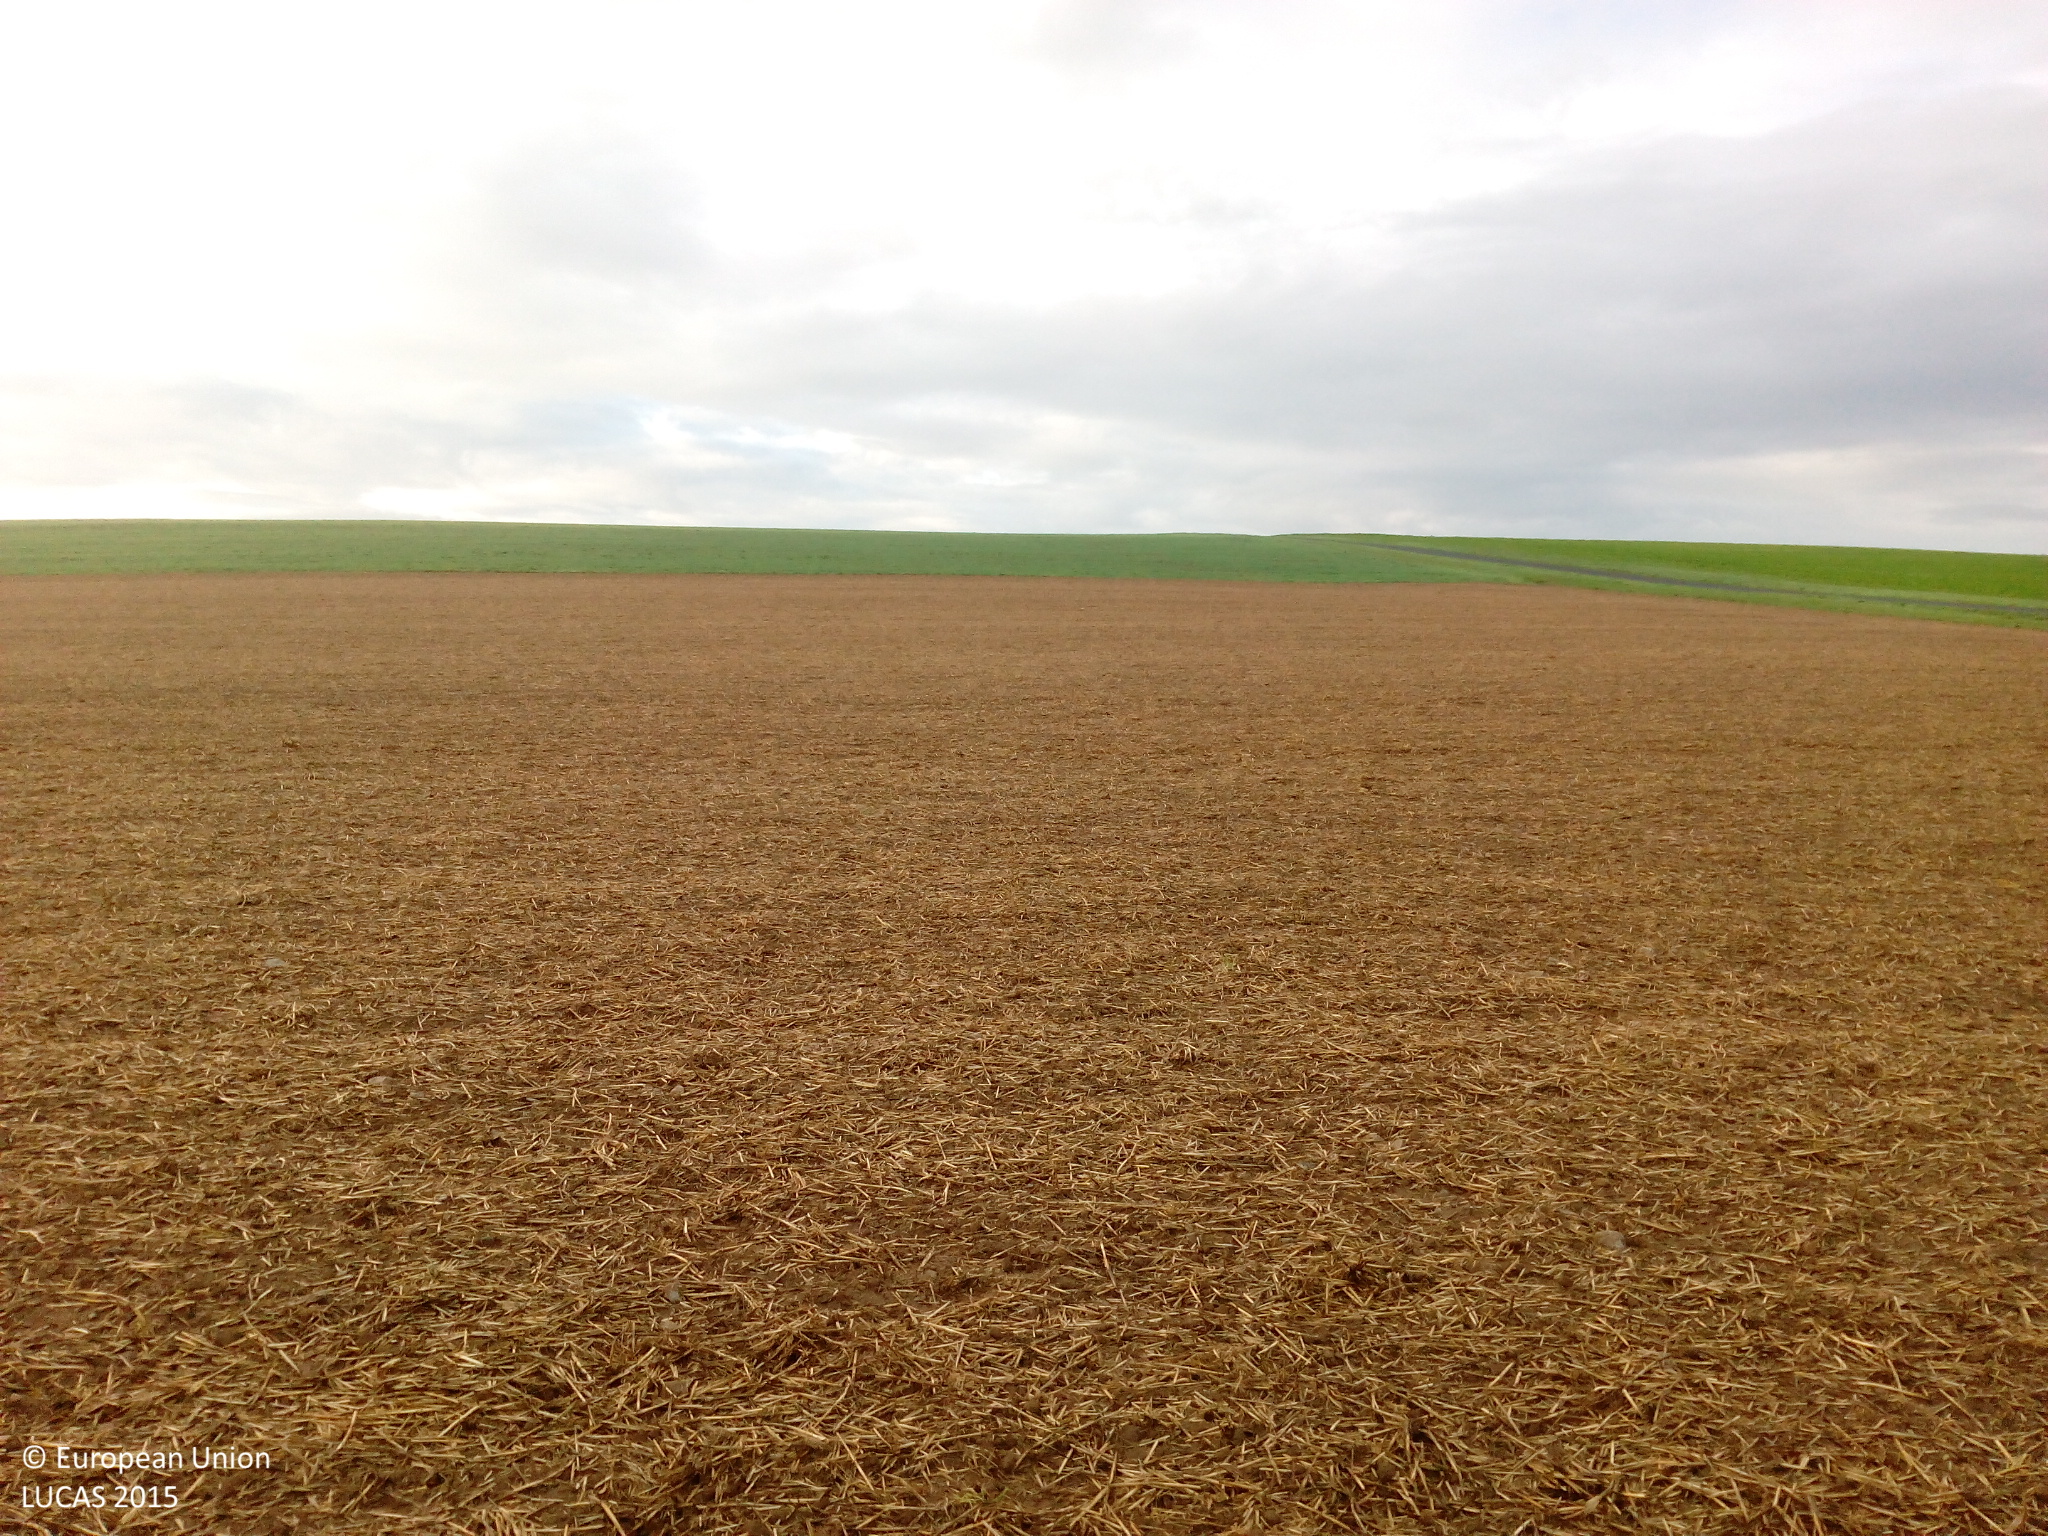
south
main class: Cropland
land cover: Rye
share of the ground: < 10 %
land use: Agriculture (excluding fallow land and kitchen gardens)
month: September
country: DE
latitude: 49.9324
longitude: 9.8468
